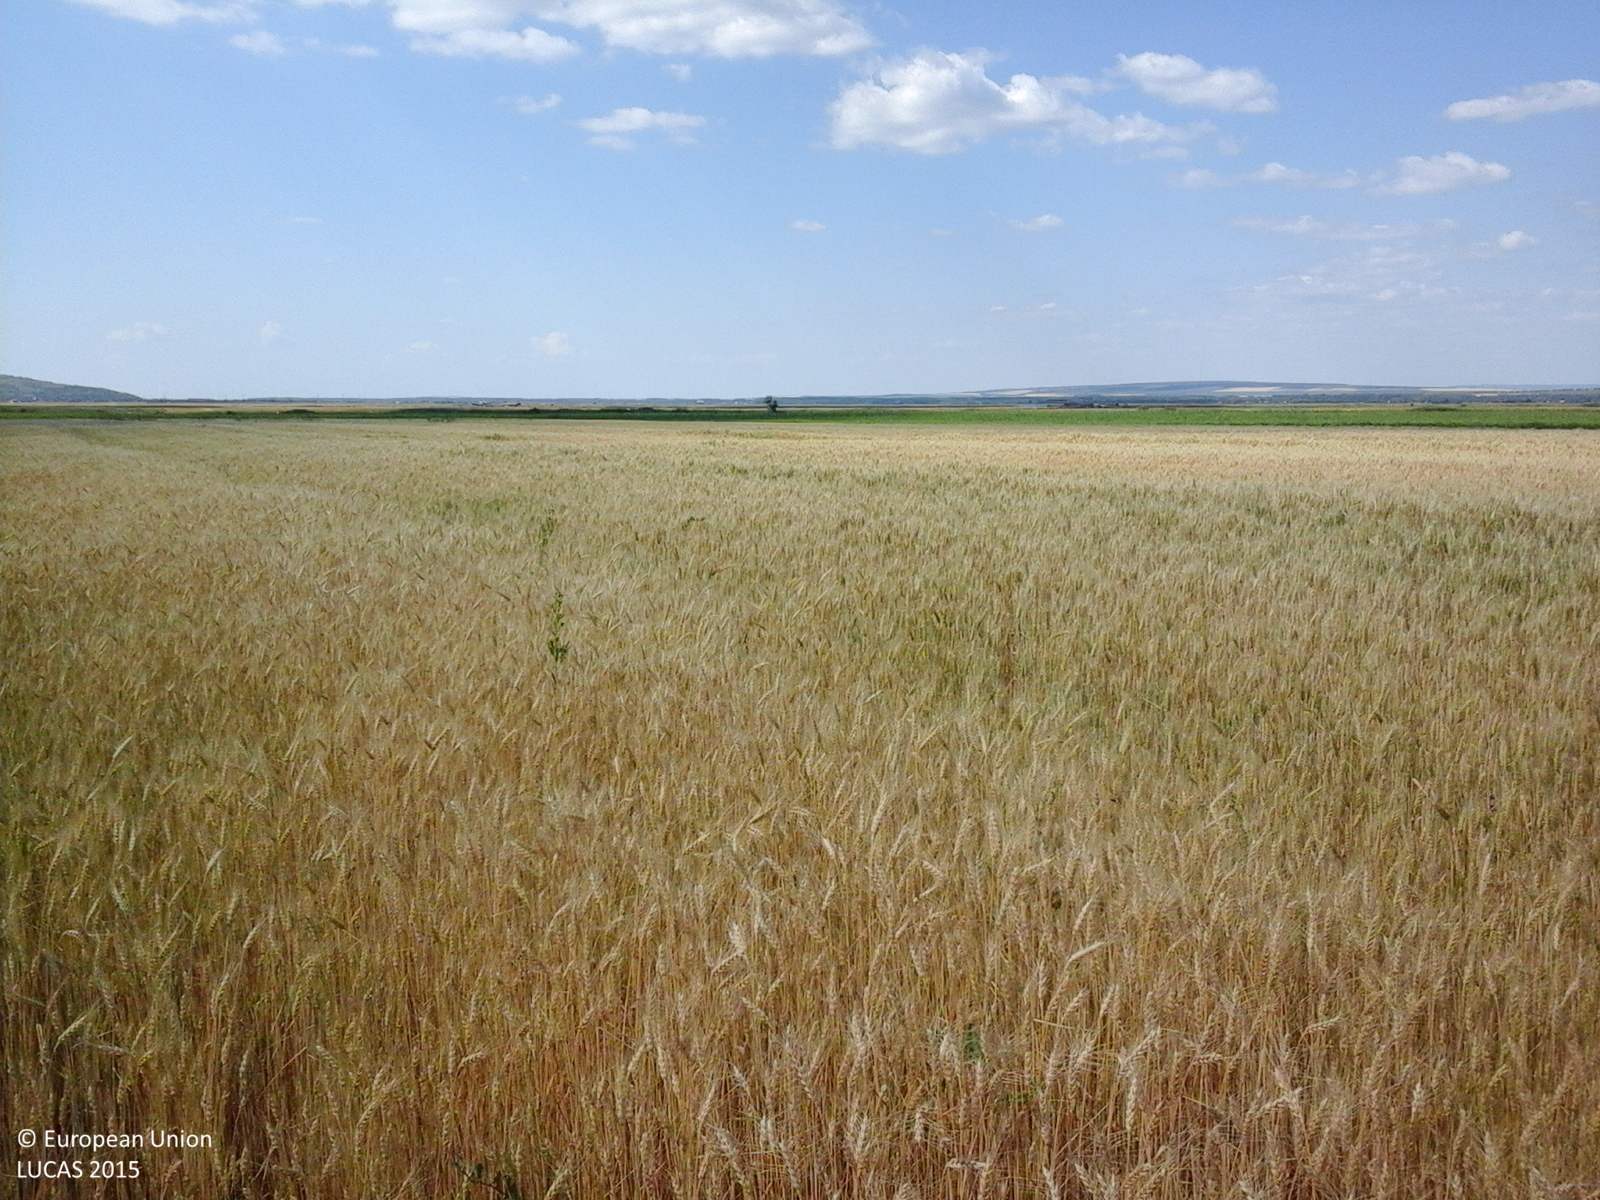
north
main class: Cropland
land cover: Durum wheat
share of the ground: > 75 %
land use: Agriculture (excluding fallow land and kitchen gardens)
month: June
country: RO
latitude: 47.0488
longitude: 27.8297
